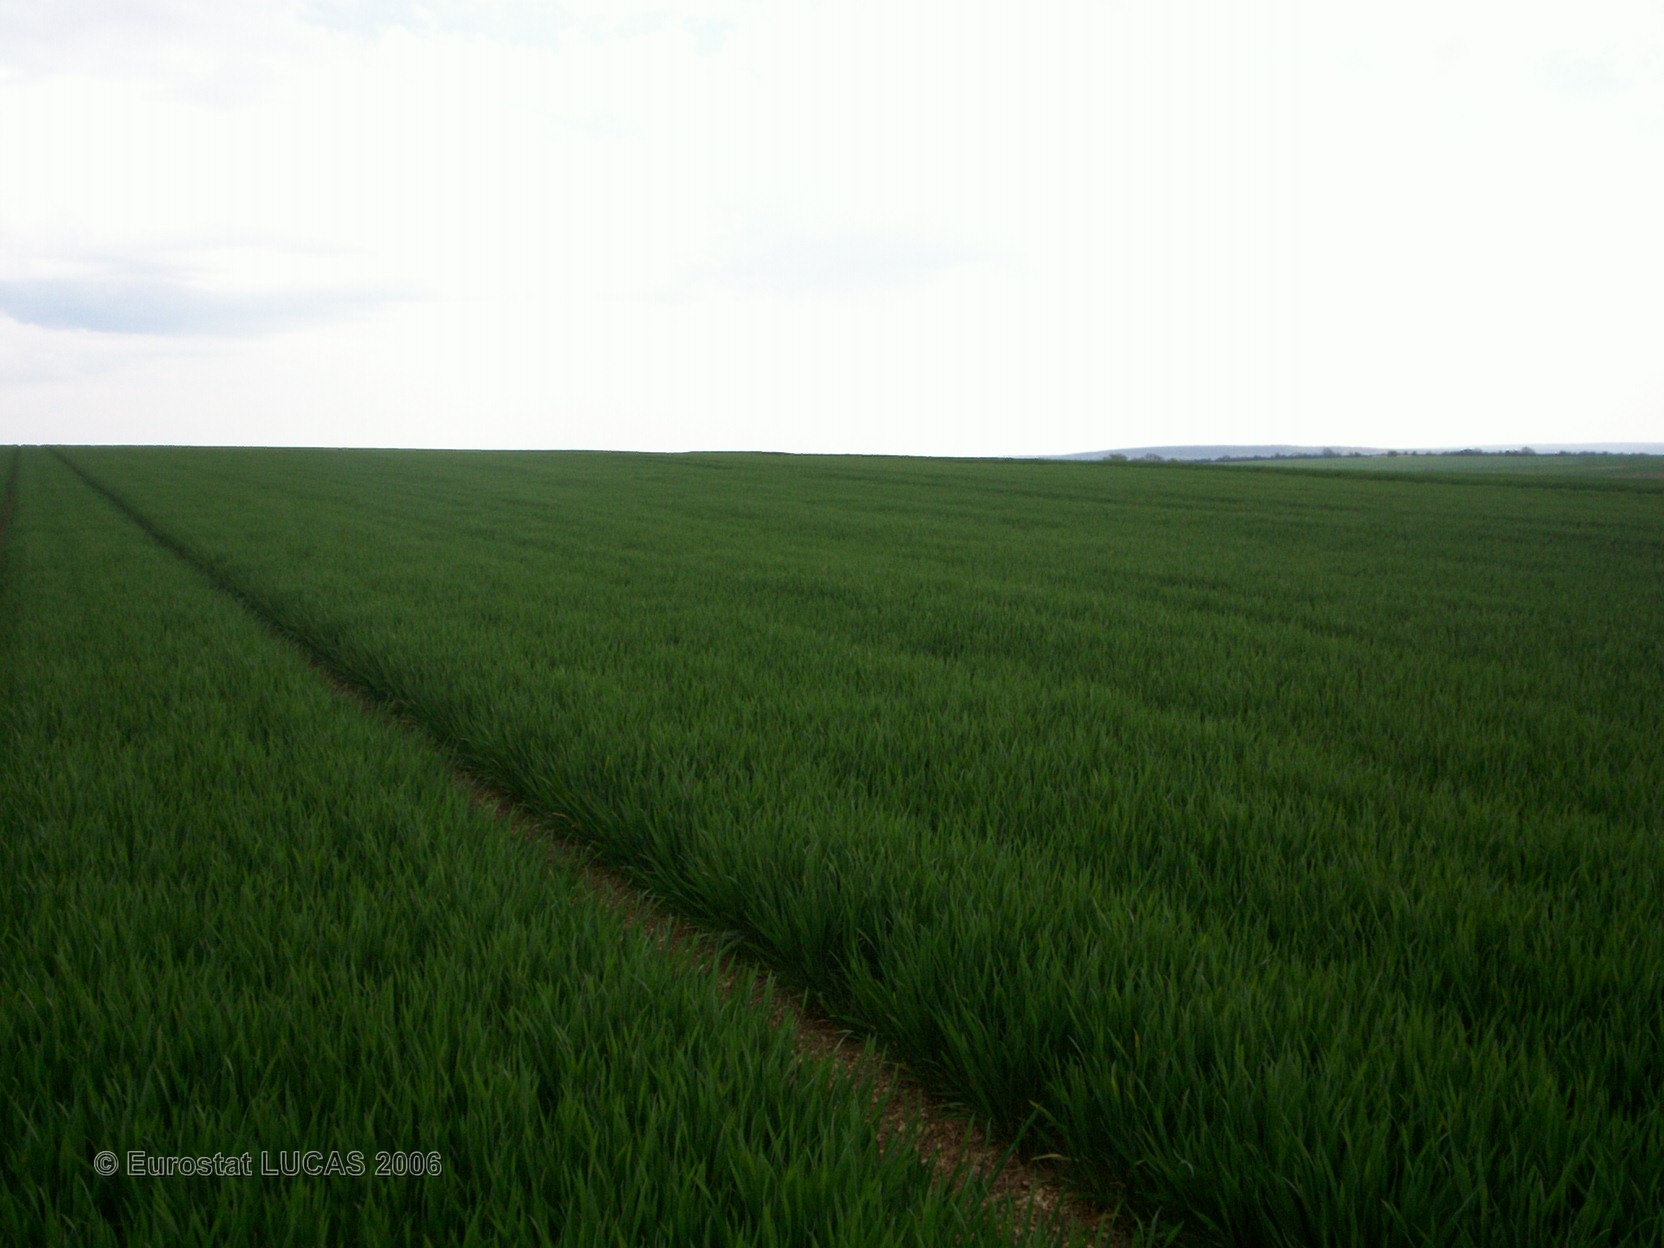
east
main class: Cropland
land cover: Common wheat
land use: Agriculture (excluding fallow land and kitchen gardens)
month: April
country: FR
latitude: 47.3535
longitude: 3.0446
